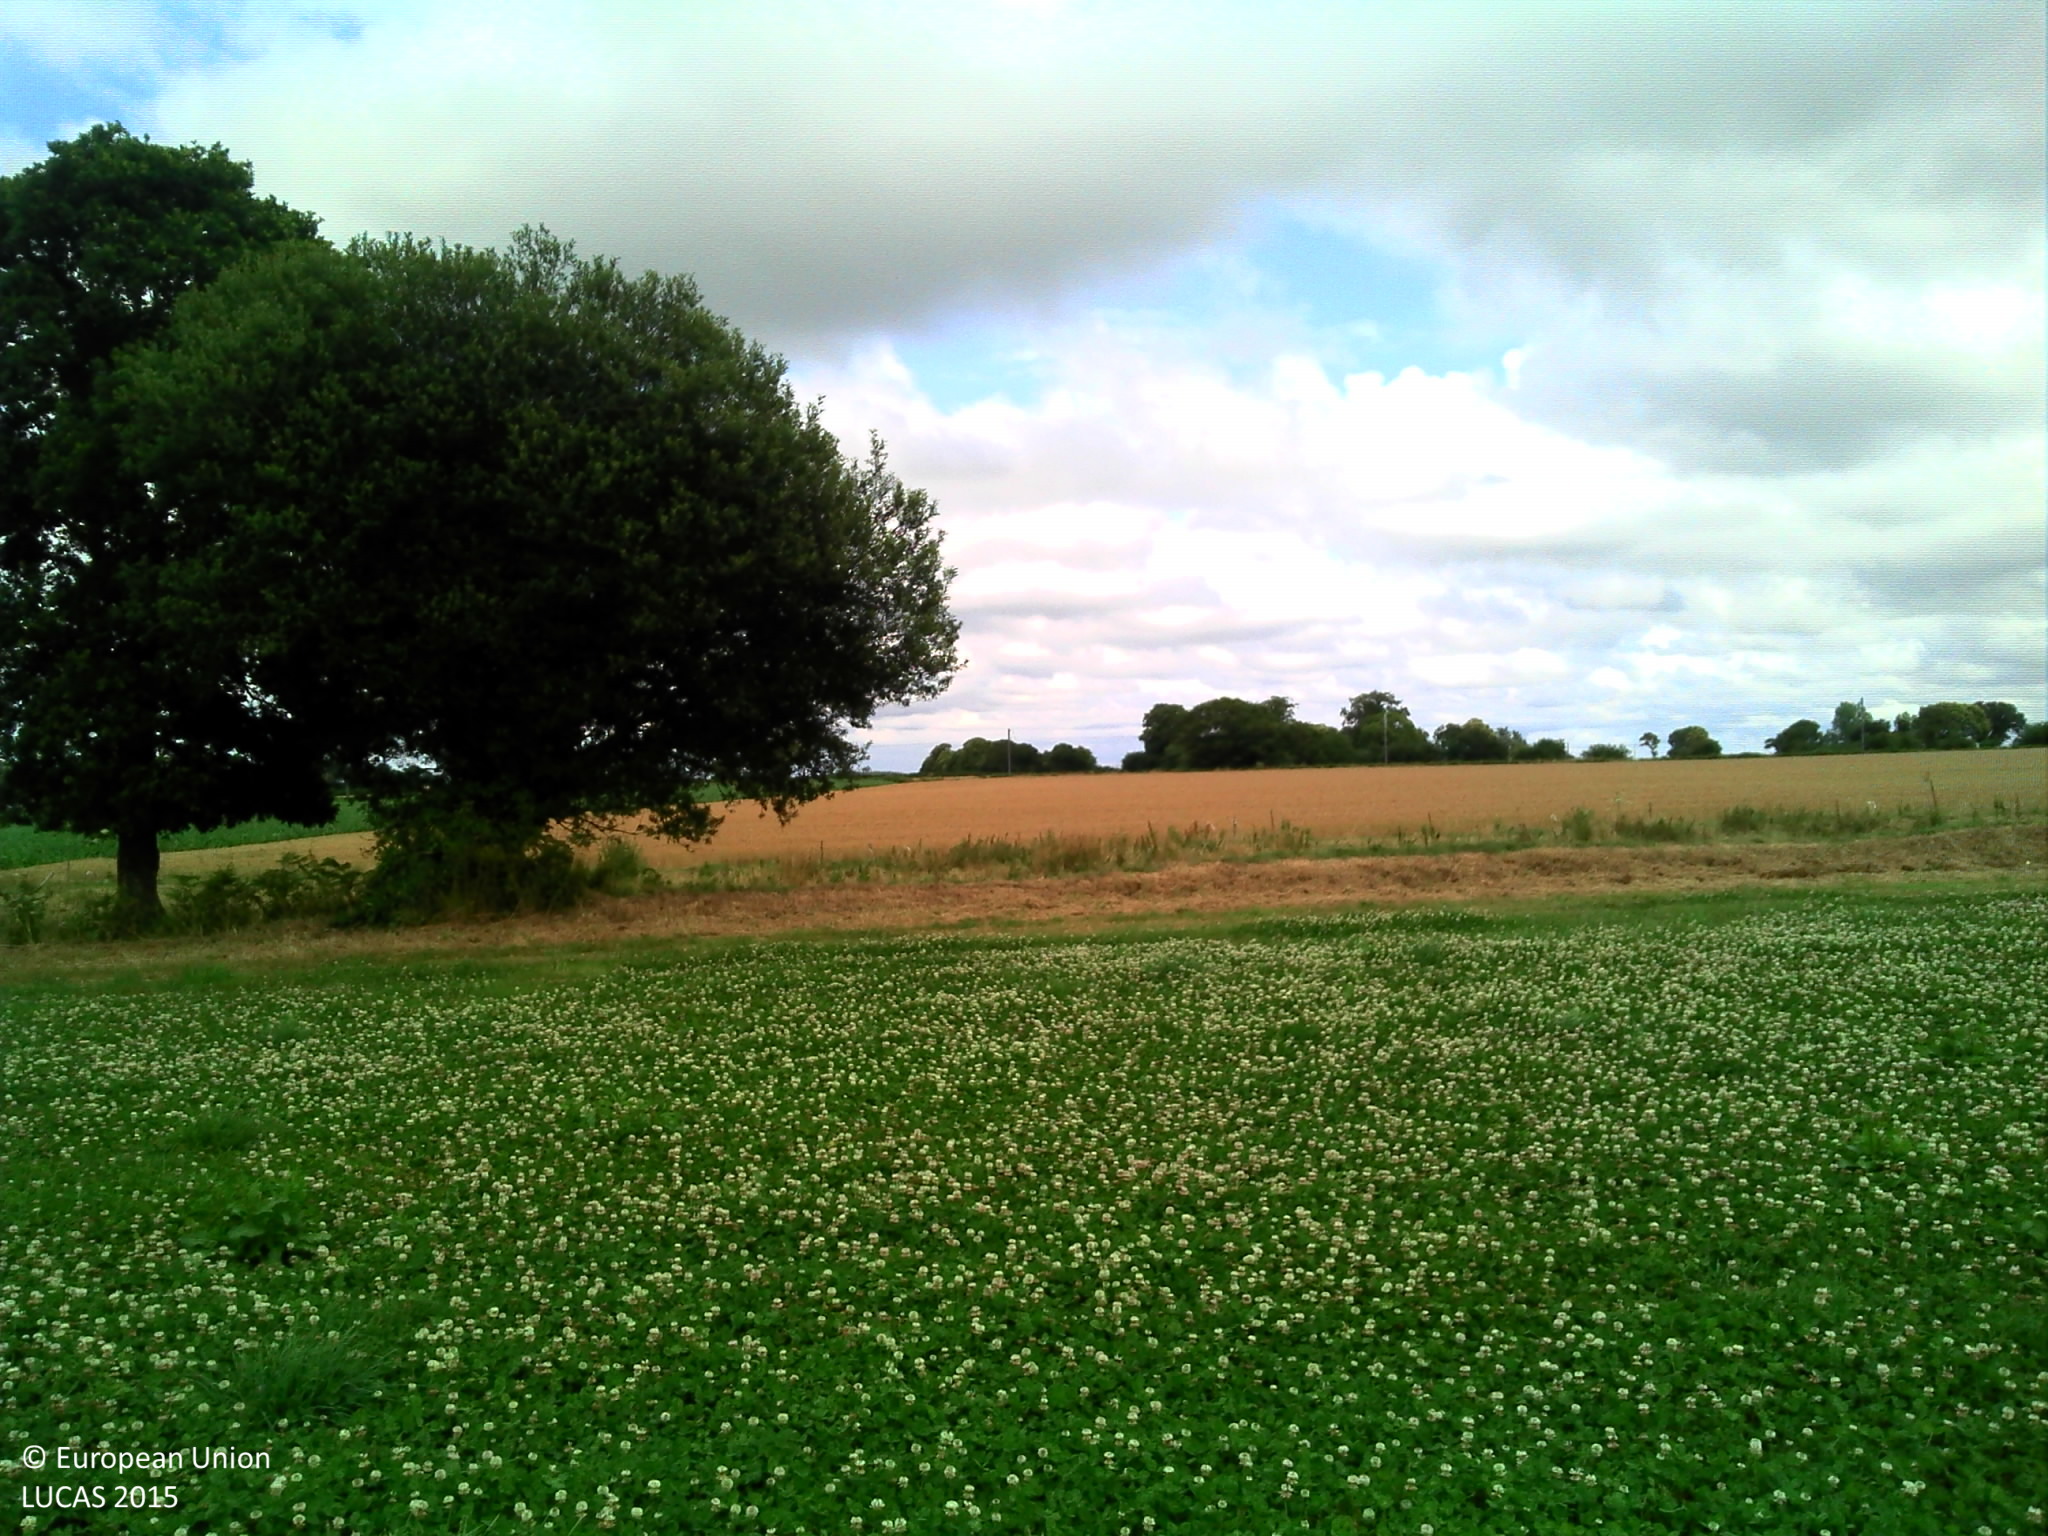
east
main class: Cropland
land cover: Clovers
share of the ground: > 75 %
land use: Agriculture (excluding fallow land and kitchen gardens)
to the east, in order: Clovers; Fences; Grassland without tree/shrub cover; Fences; Common wheat
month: July
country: FR
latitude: 48.6532
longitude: -3.4497
